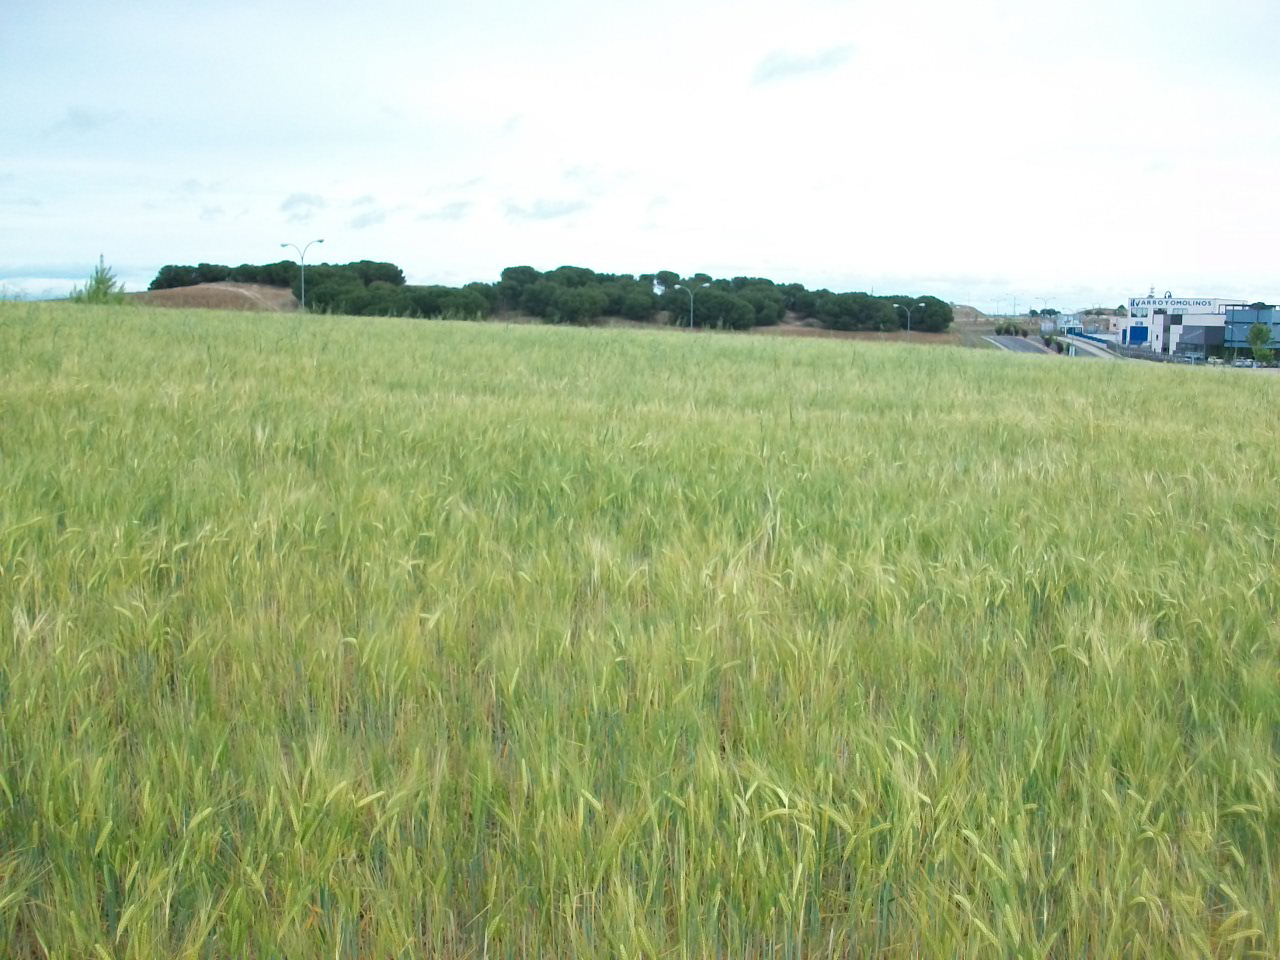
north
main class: Cropland
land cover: Barley
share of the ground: > 75 %
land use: Agriculture (excluding fallow land and kitchen gardens)
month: April
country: ES
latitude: 40.2975
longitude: -3.9091
